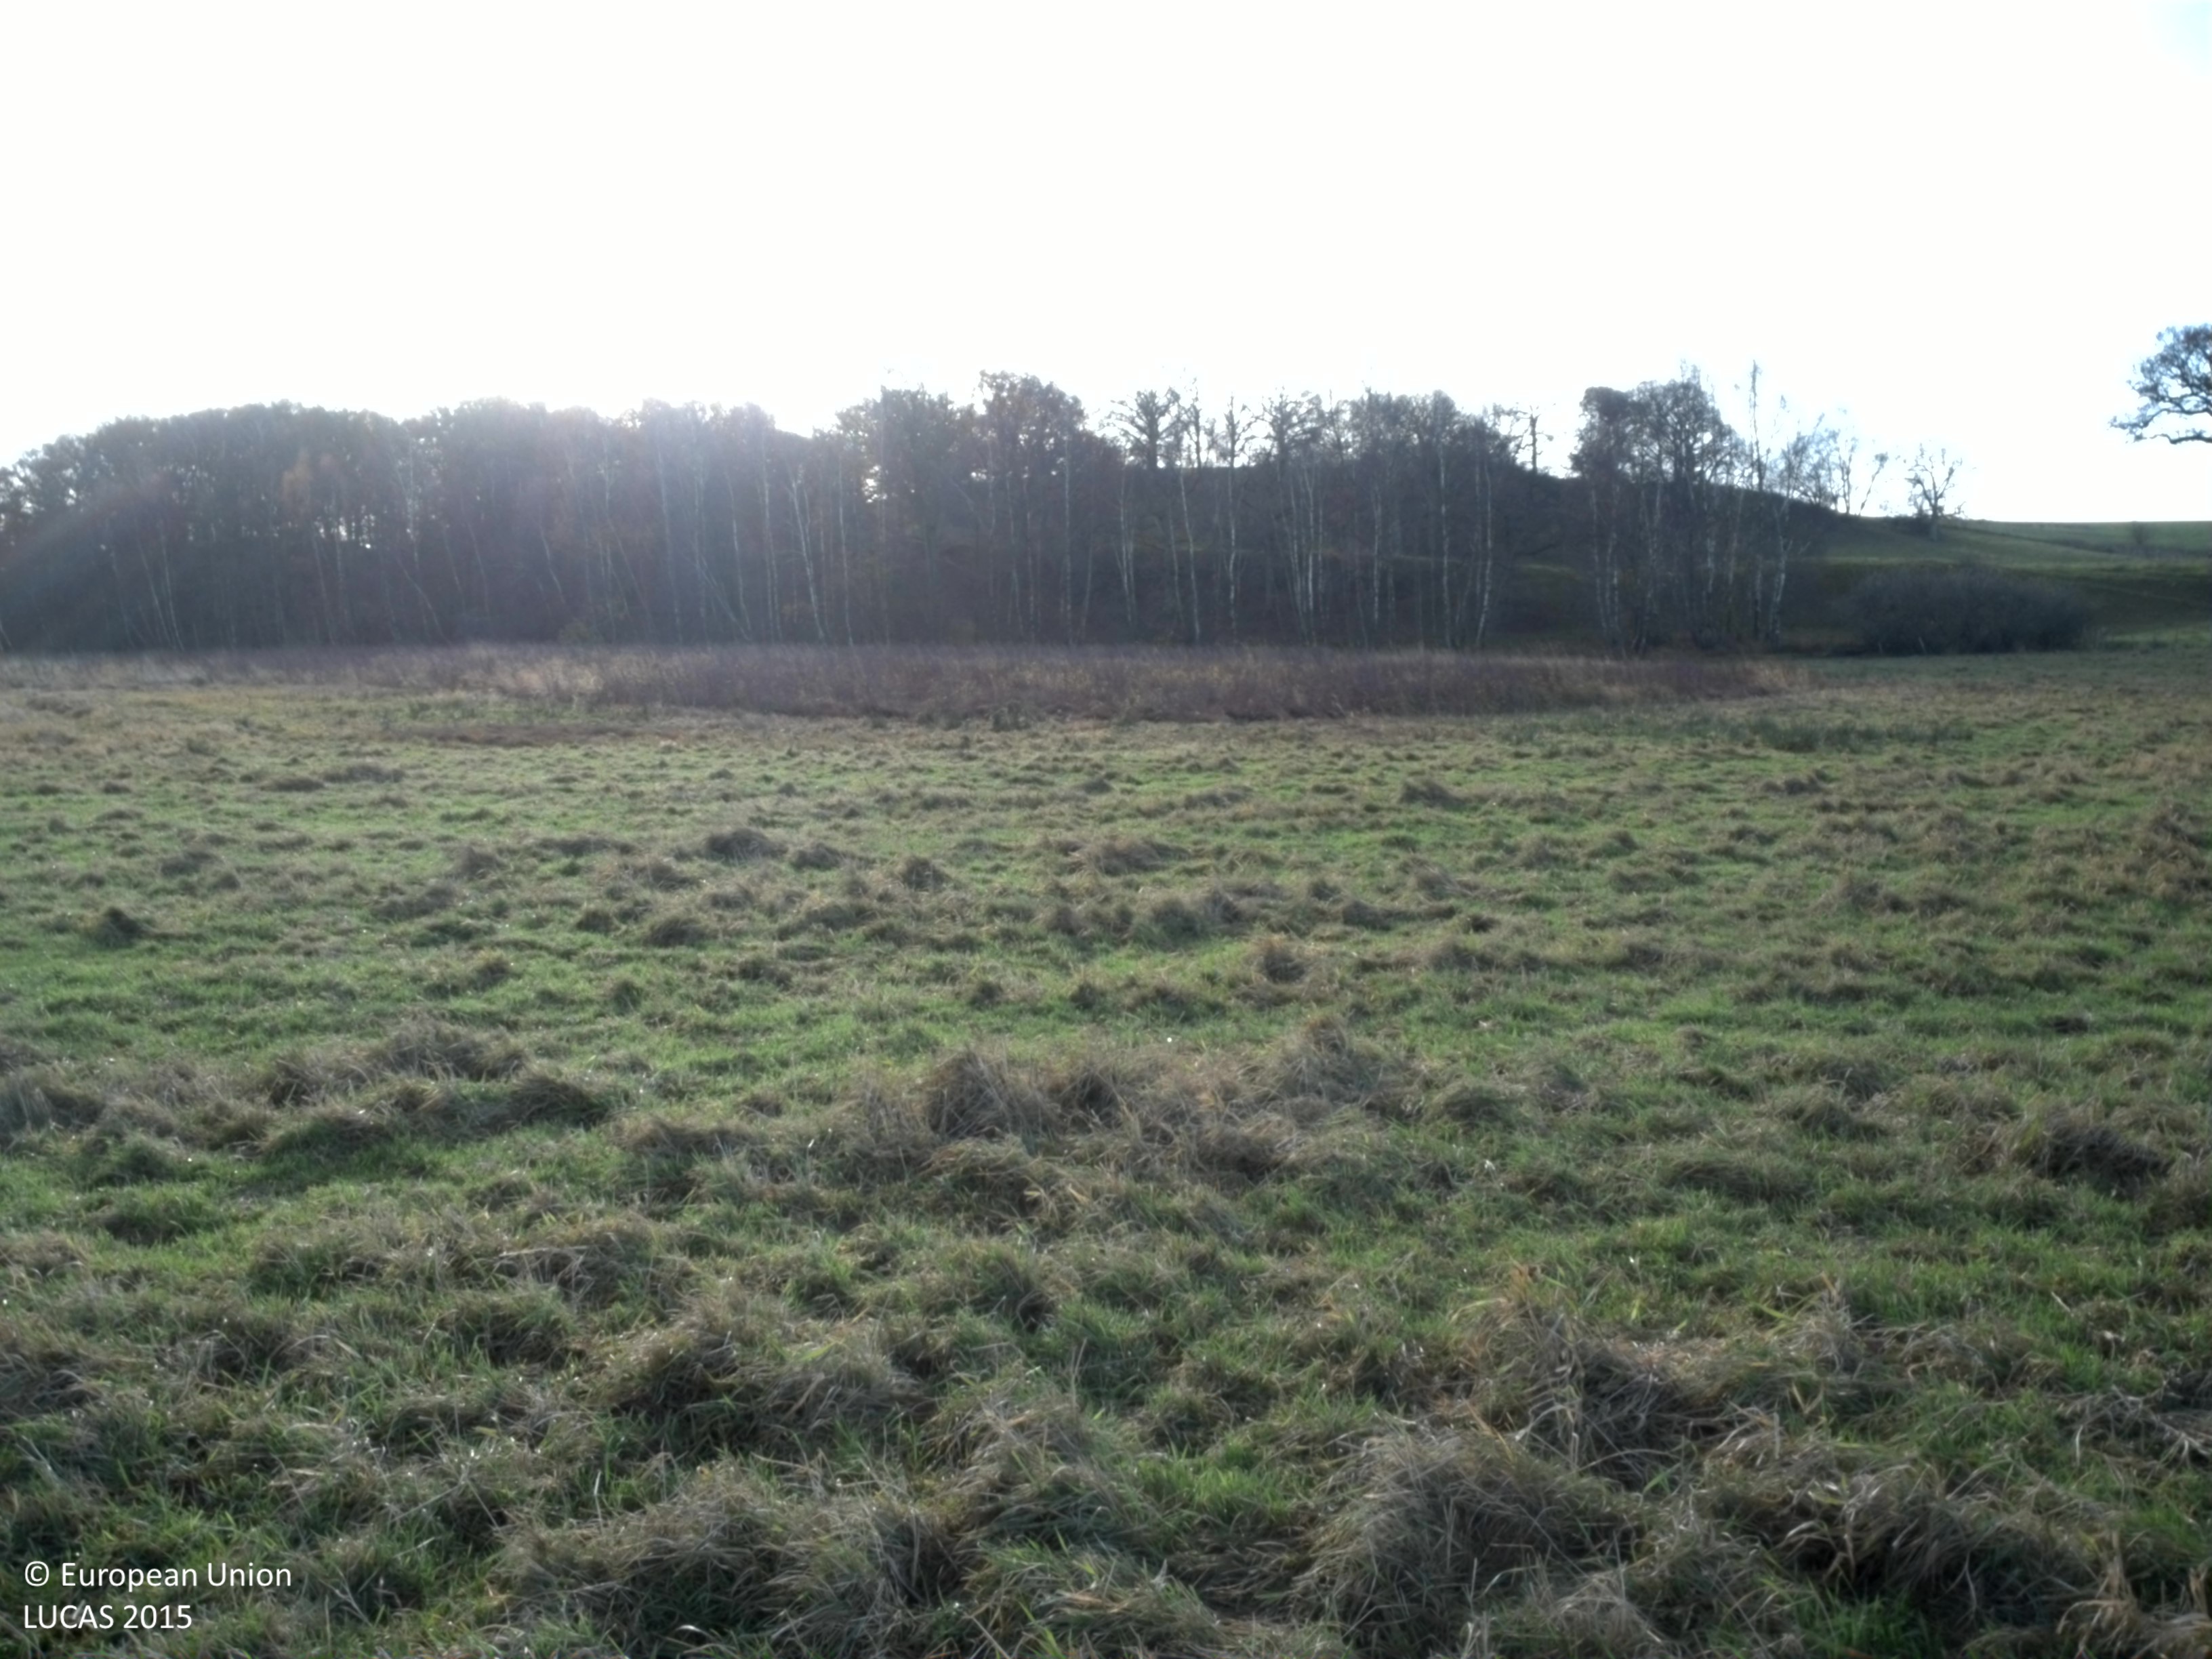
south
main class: Grassland
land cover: Grassland without tree/shrub cover
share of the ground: > 75 %
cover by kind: herbaceous plants 100 %
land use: Agriculture (excluding fallow land and kitchen gardens)
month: November
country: SE
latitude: 56.1510
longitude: 13.0721
